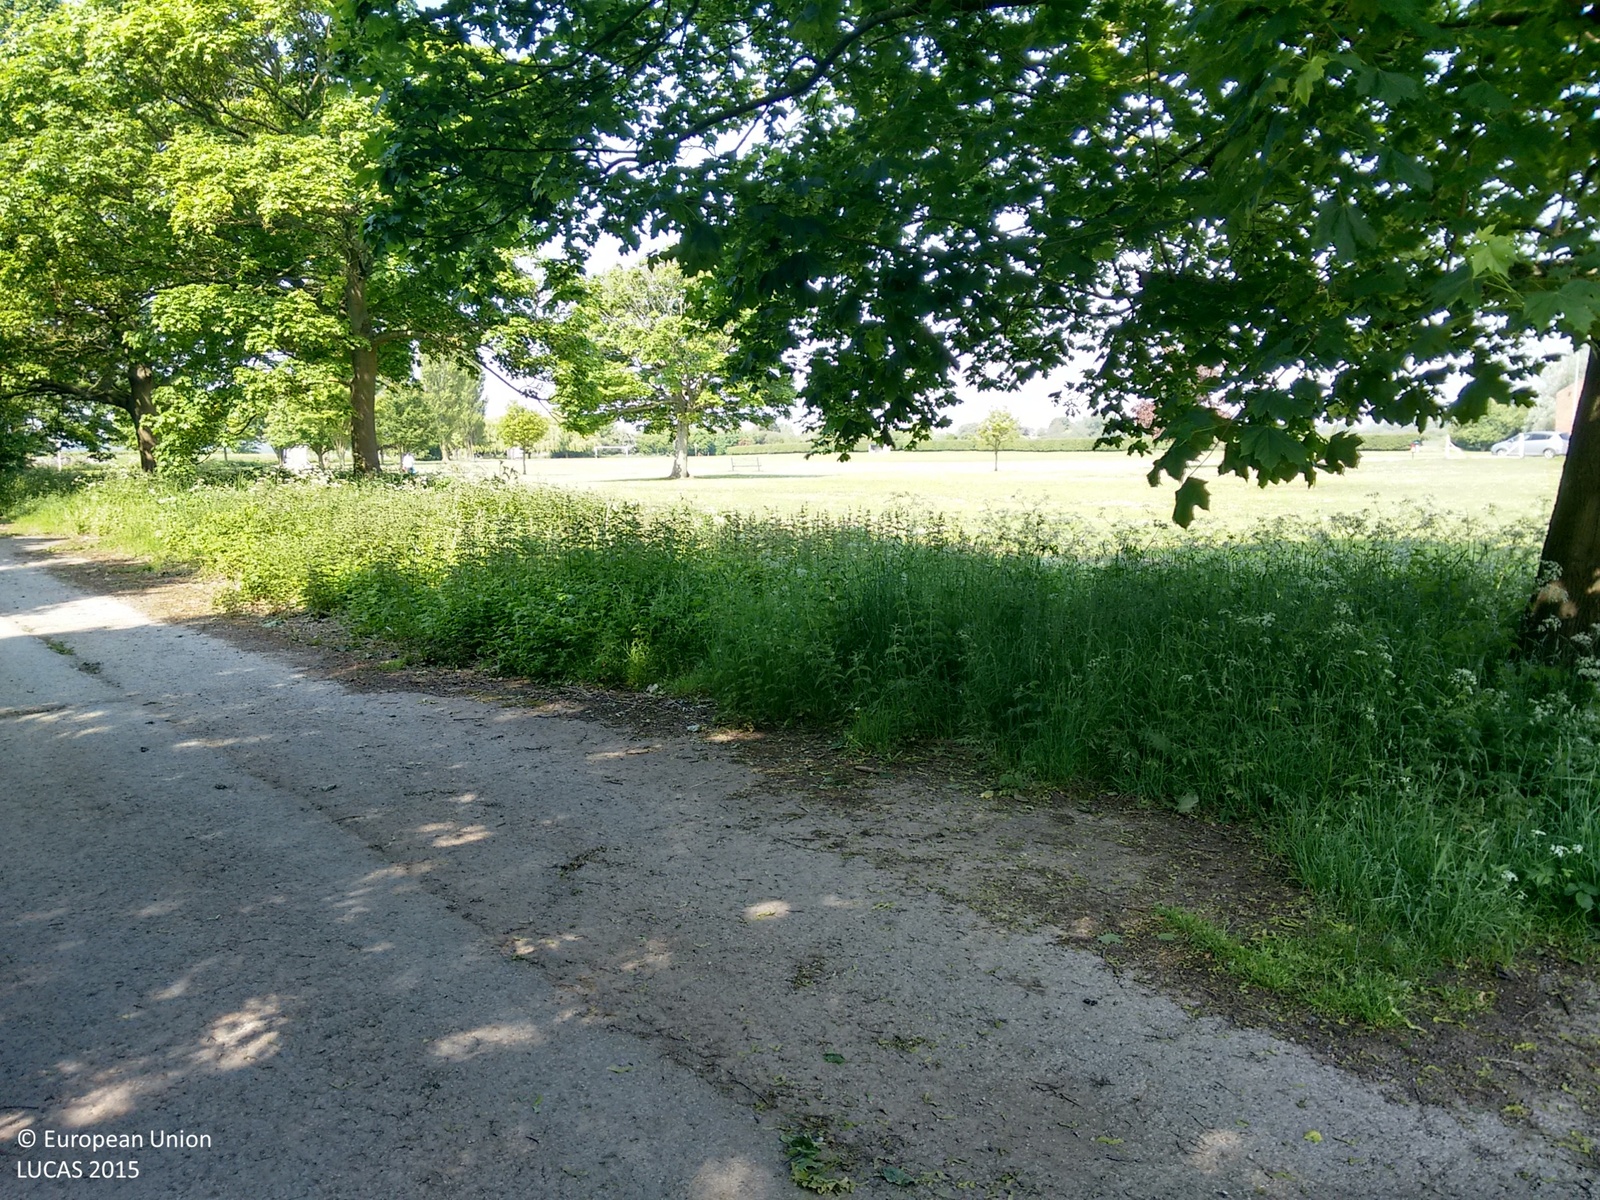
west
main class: Woodland
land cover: Broadleaved woodland
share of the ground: > 75 %
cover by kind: broadleaved forest trees 100 %
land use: Semi-natural and natural areas not in use
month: June
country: GB
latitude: 53.9533
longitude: -1.1845
